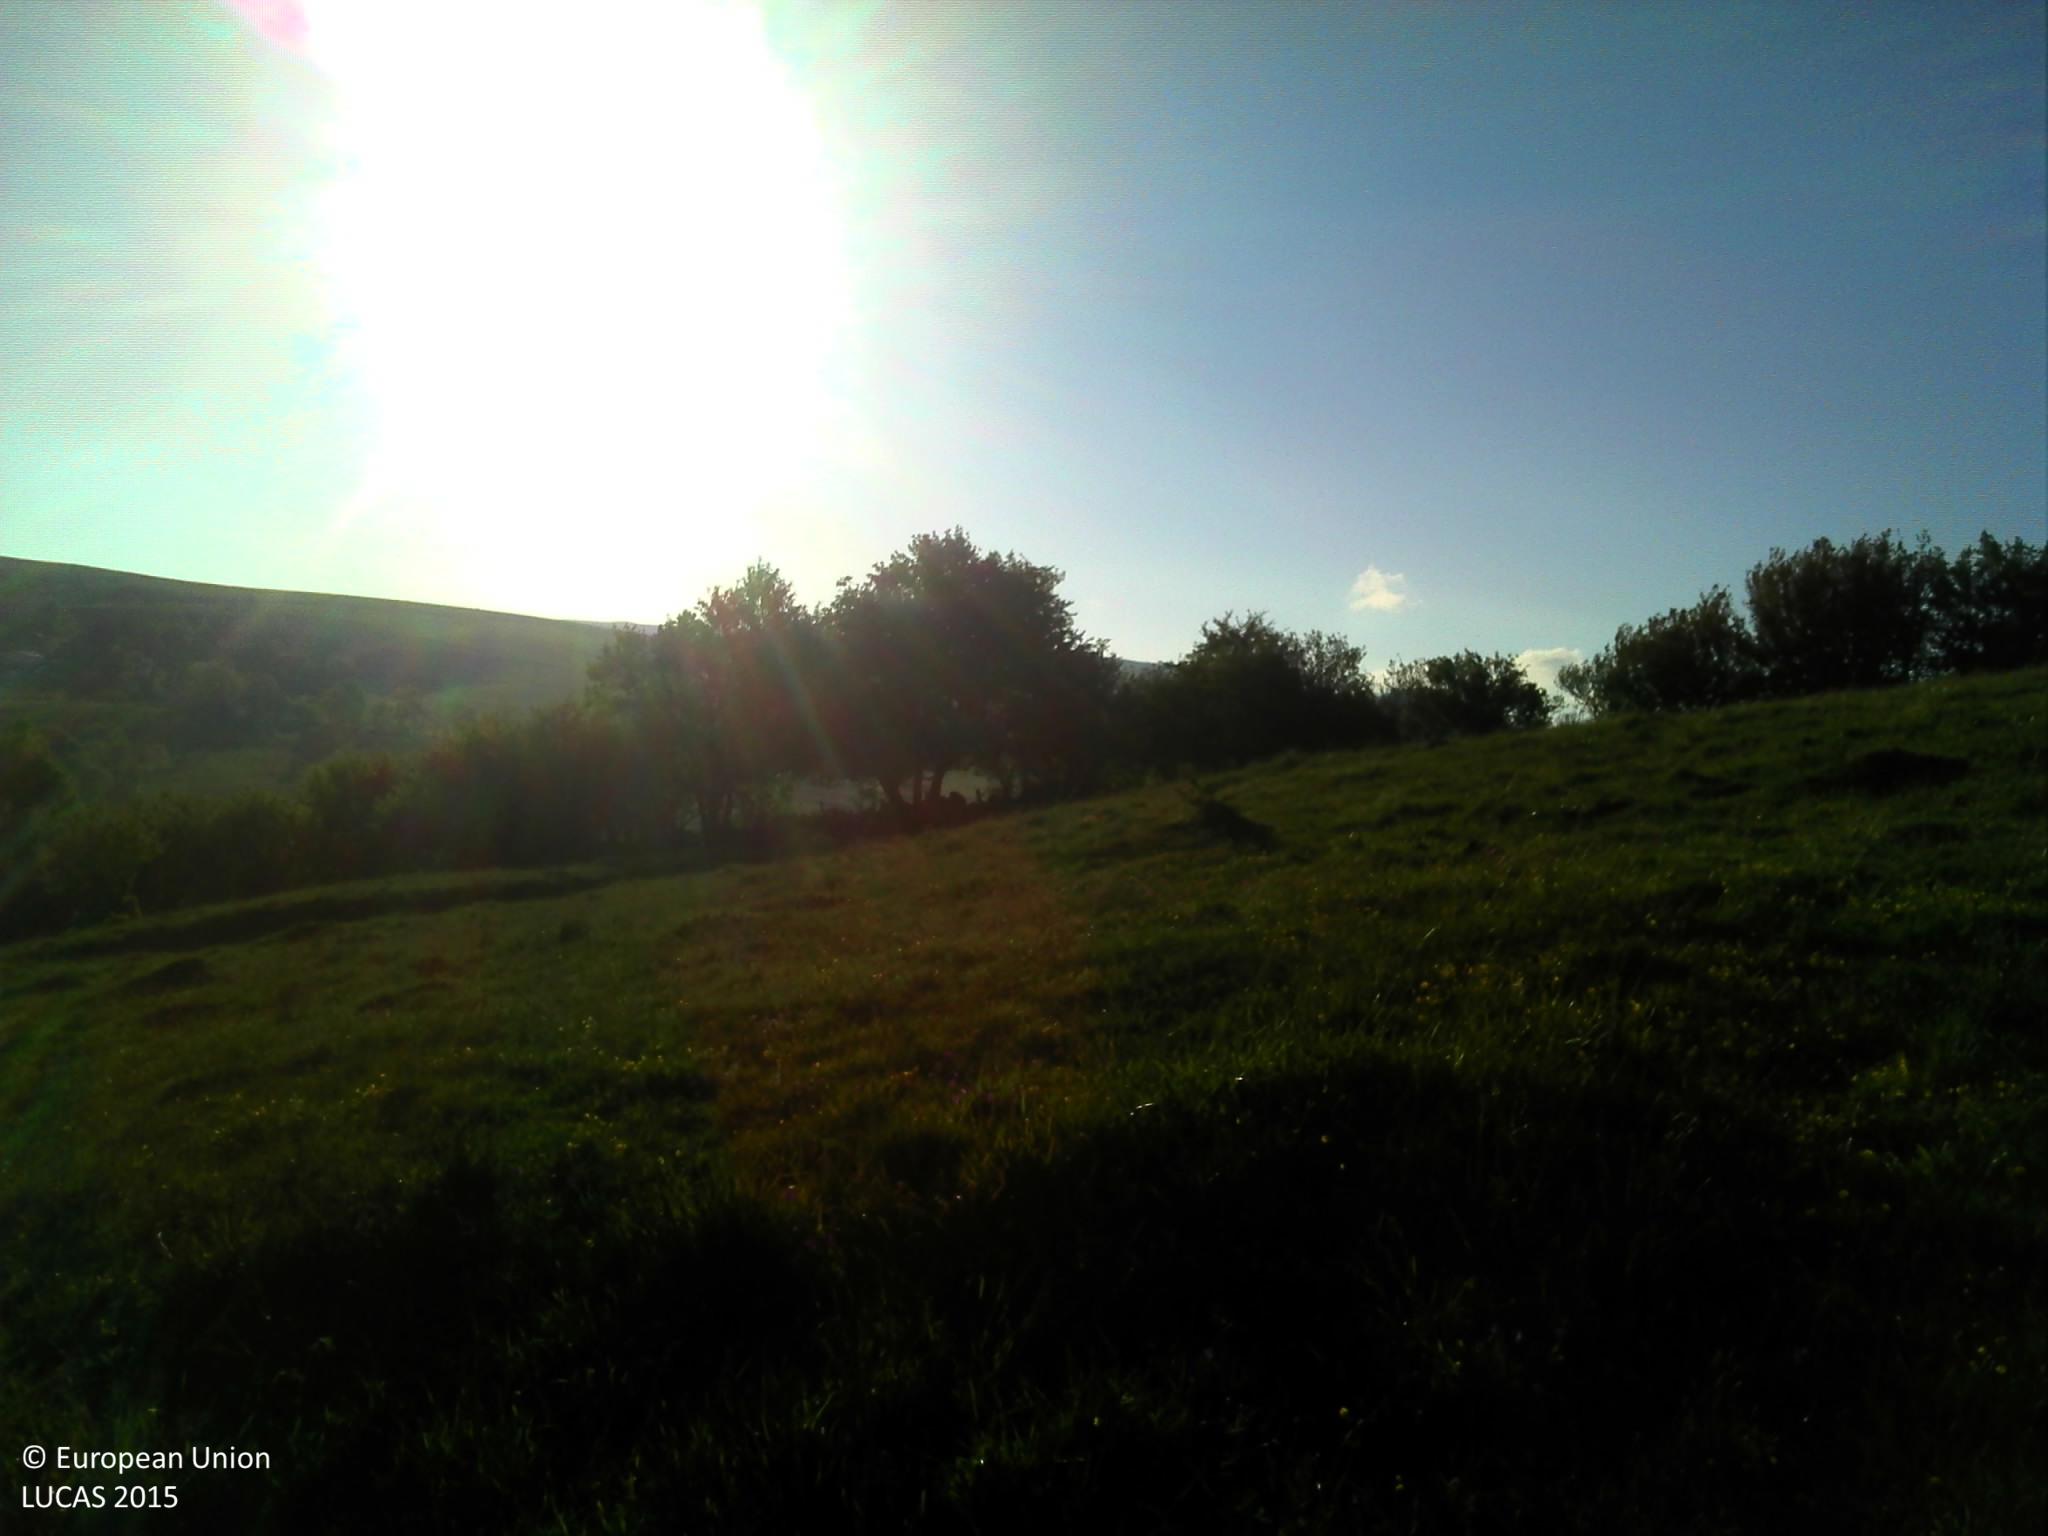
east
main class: Grassland
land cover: Grassland without tree/shrub cover
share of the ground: > 75 %
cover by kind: herbaceous plants 100 %
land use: Agriculture (excluding fallow land and kitchen gardens)
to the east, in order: Grassland without tree/shrub cover; Tracks; Grassland without tree/shrub cover; Abandoned hedges; Dry stone walls; Fences; Grassland without tree/shrub cover; Dry stone walls; Broadleaved woodland; Rivers and streams; Broadleaved woodland; Dry stone walls; Fences; Broadleaved woodland
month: May
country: FR
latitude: 45.3533
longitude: 2.8650
